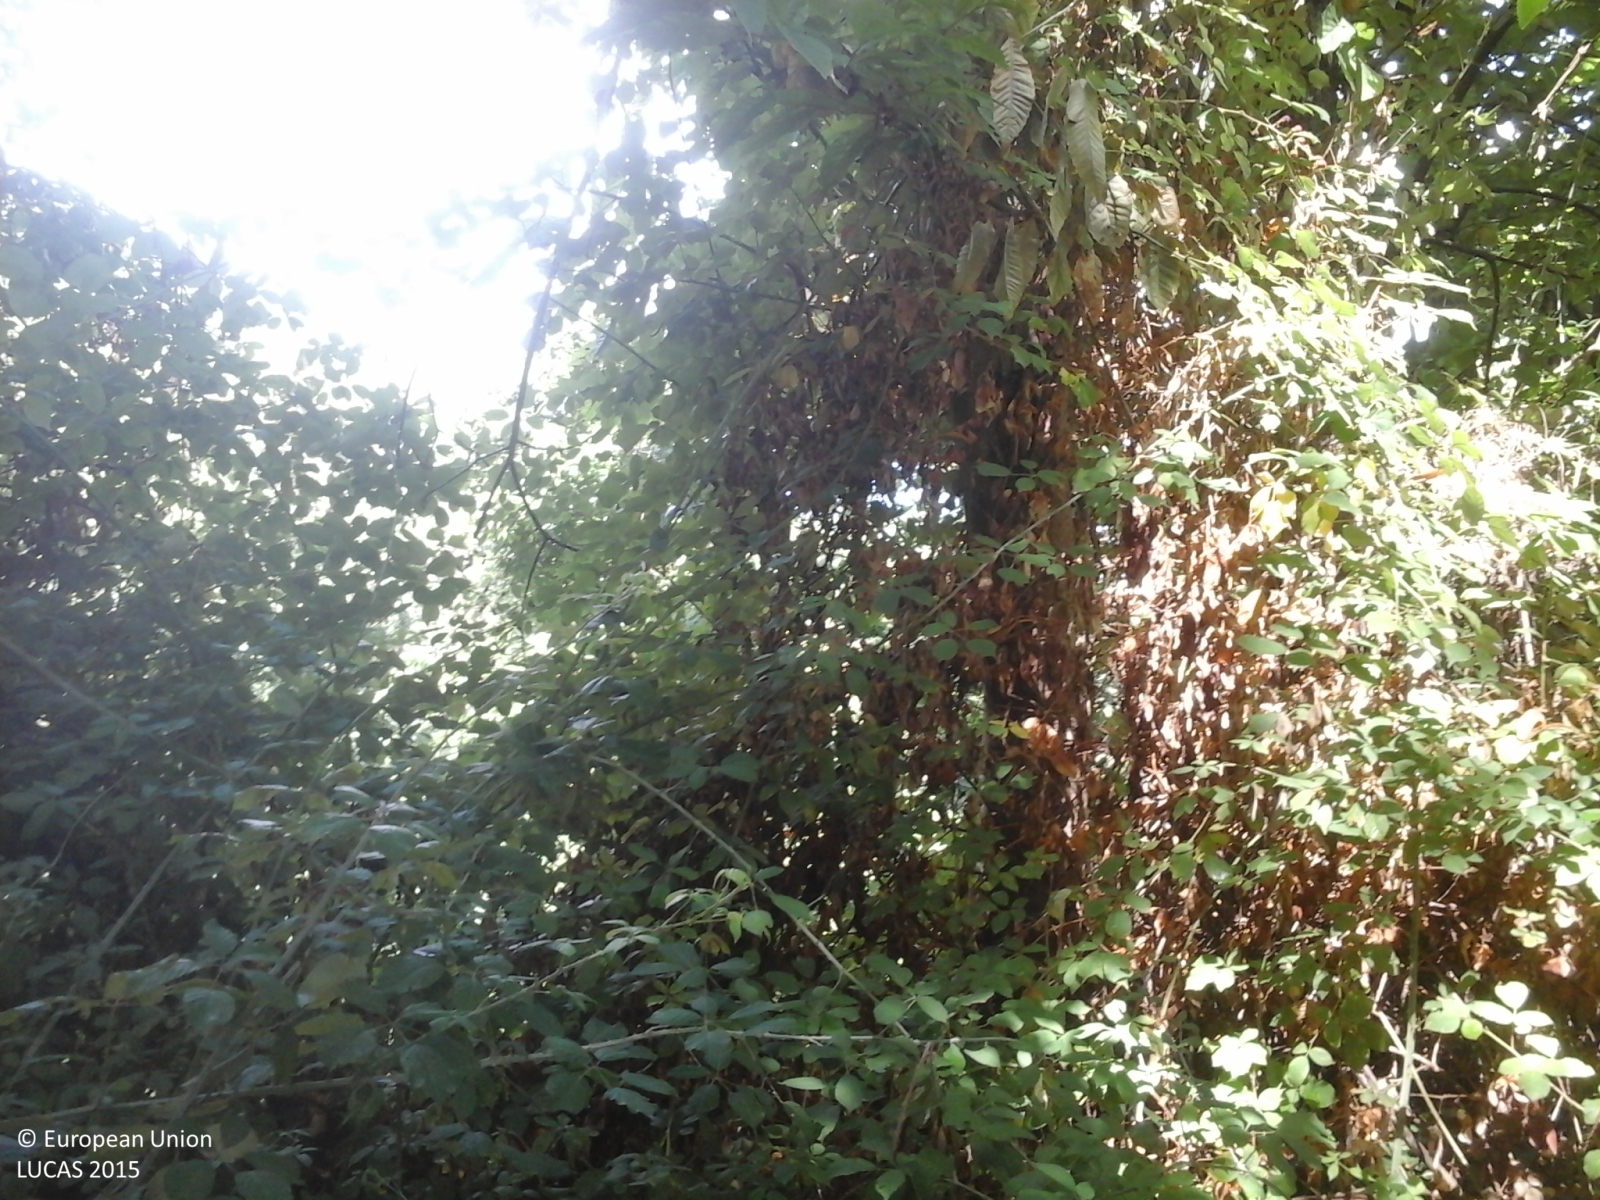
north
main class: Woodland
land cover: Broadleaved woodland
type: thermophilous deciduous forest
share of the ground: > 75 %
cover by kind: broadleaved forest trees 100 %
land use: Forestry
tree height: > 5 m
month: August
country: IT
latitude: 43.8230
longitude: 10.9549
